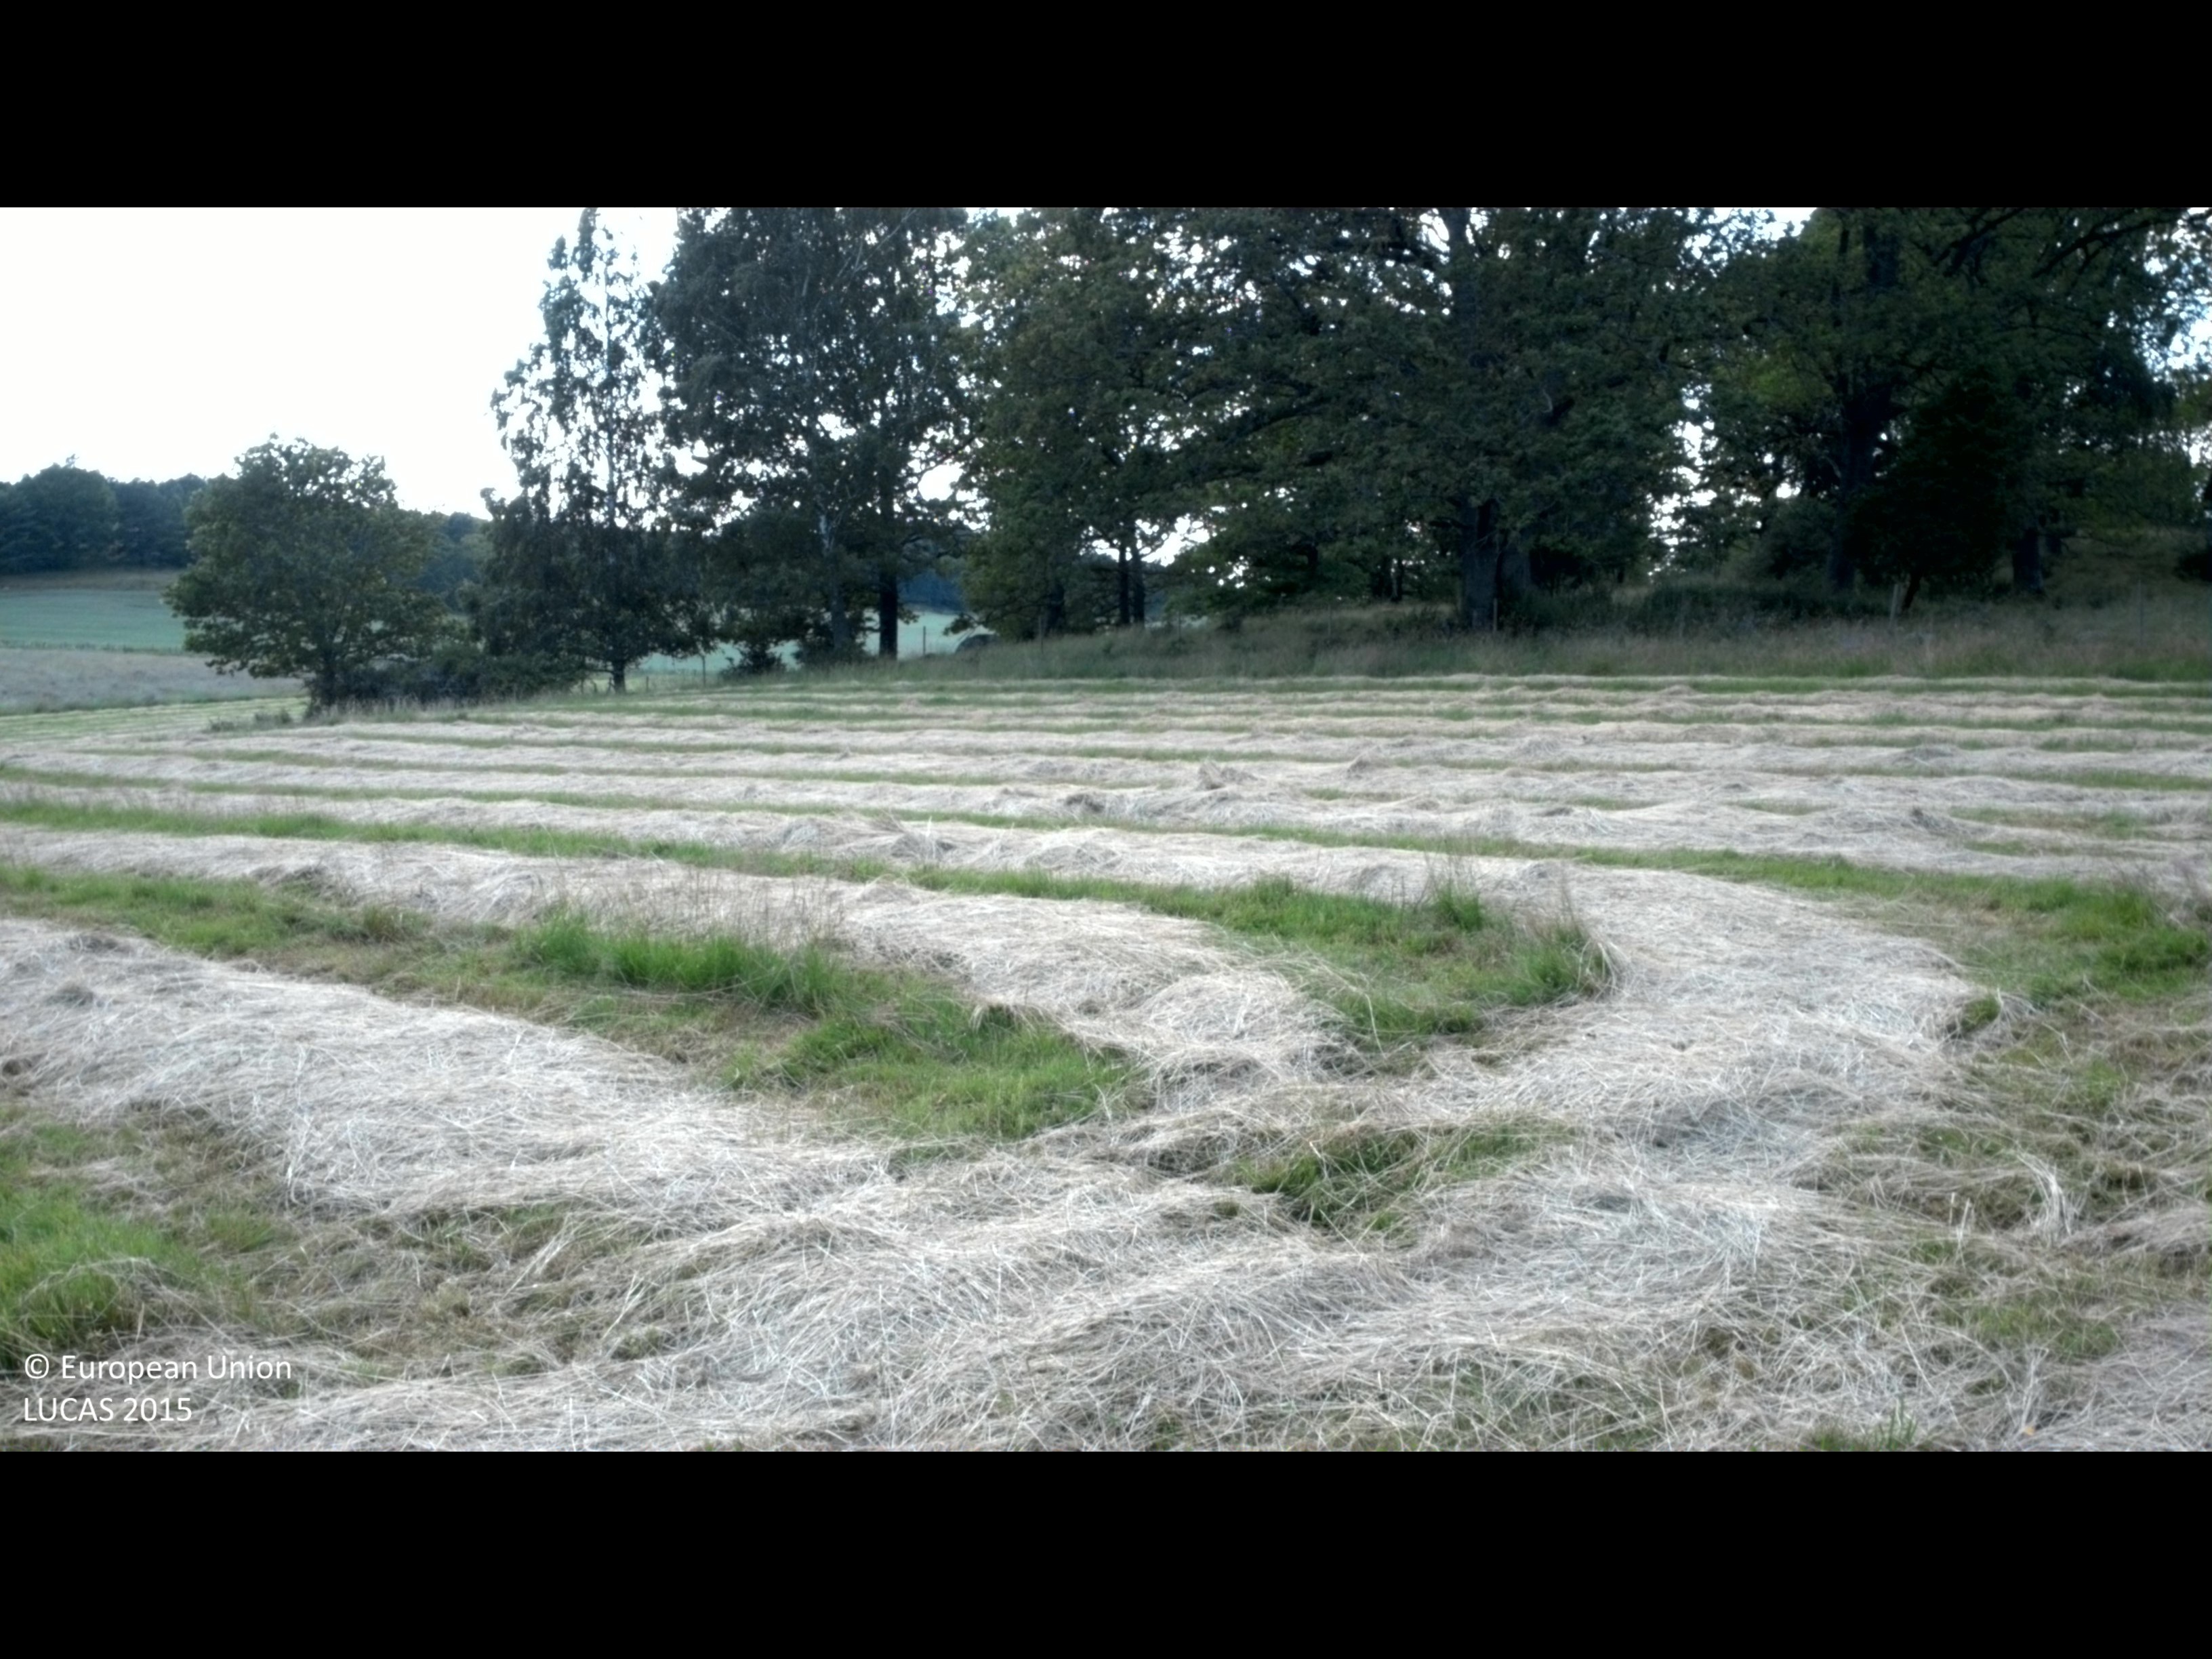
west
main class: Cropland
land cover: Other leguminous and mixtures for fodder
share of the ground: > 75 %
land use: Agriculture (excluding fallow land and kitchen gardens)
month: July
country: SE
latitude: 58.4158
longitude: 16.6558
